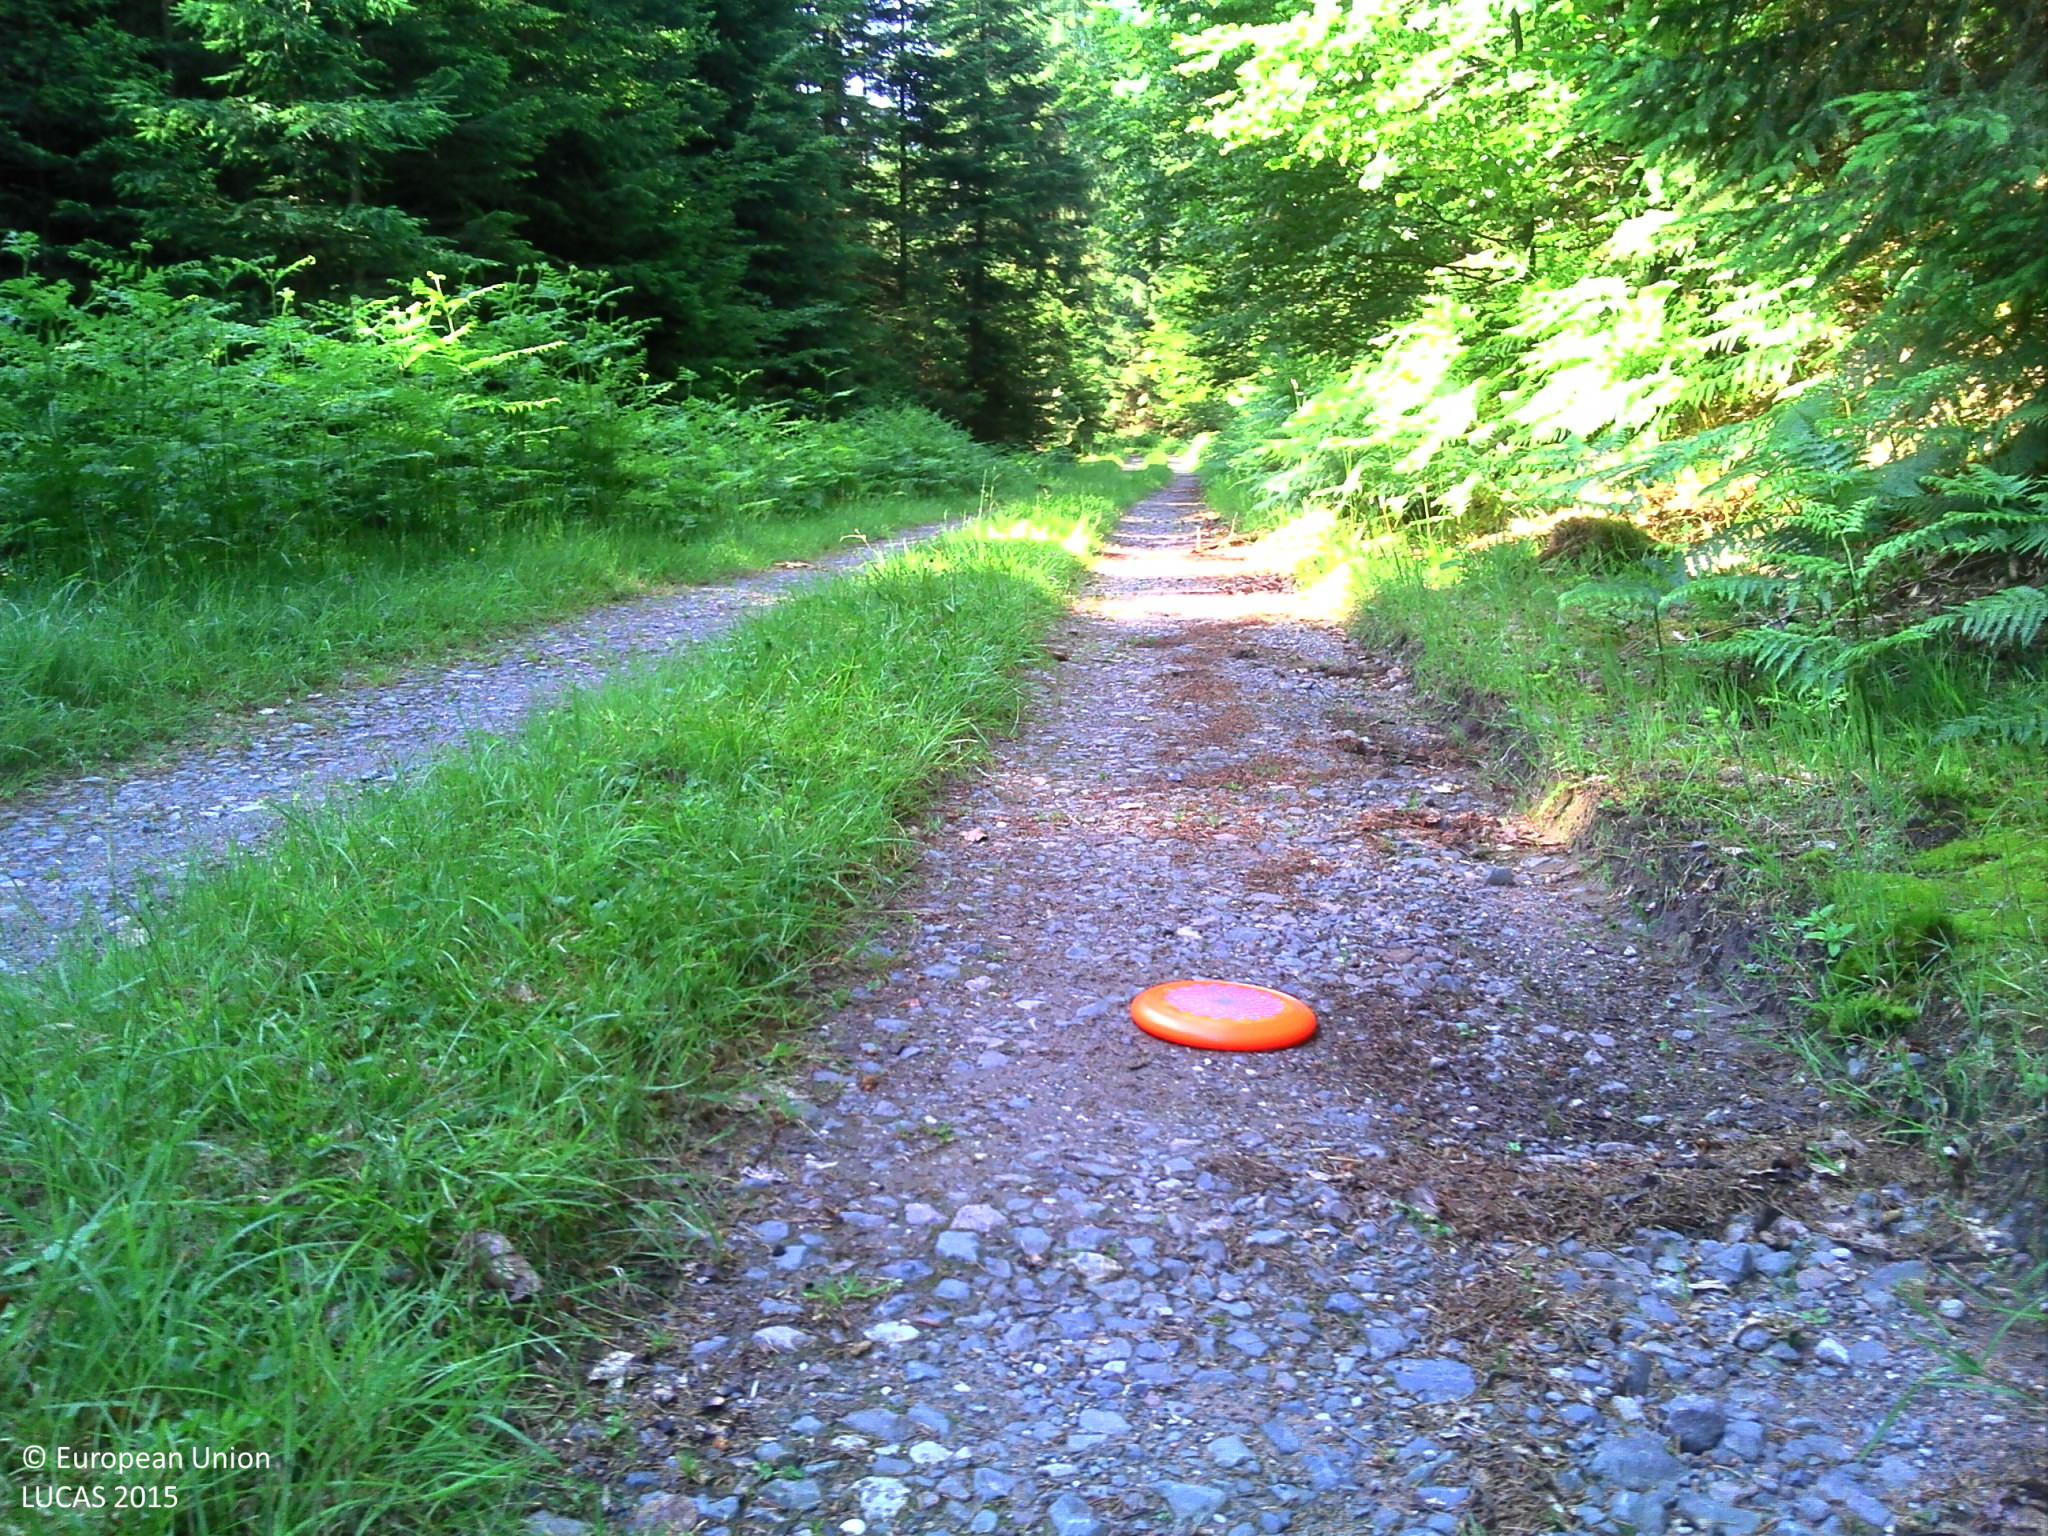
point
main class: Woodland
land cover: Spruce dominated coniferous woodland
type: alpine coniferous forest
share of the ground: > 75 %
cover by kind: coniferous forest trees 90 %, herbaceous plants 10 %
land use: Forestry
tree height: > 5 m
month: June
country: FR
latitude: 48.6759
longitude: 7.2710
